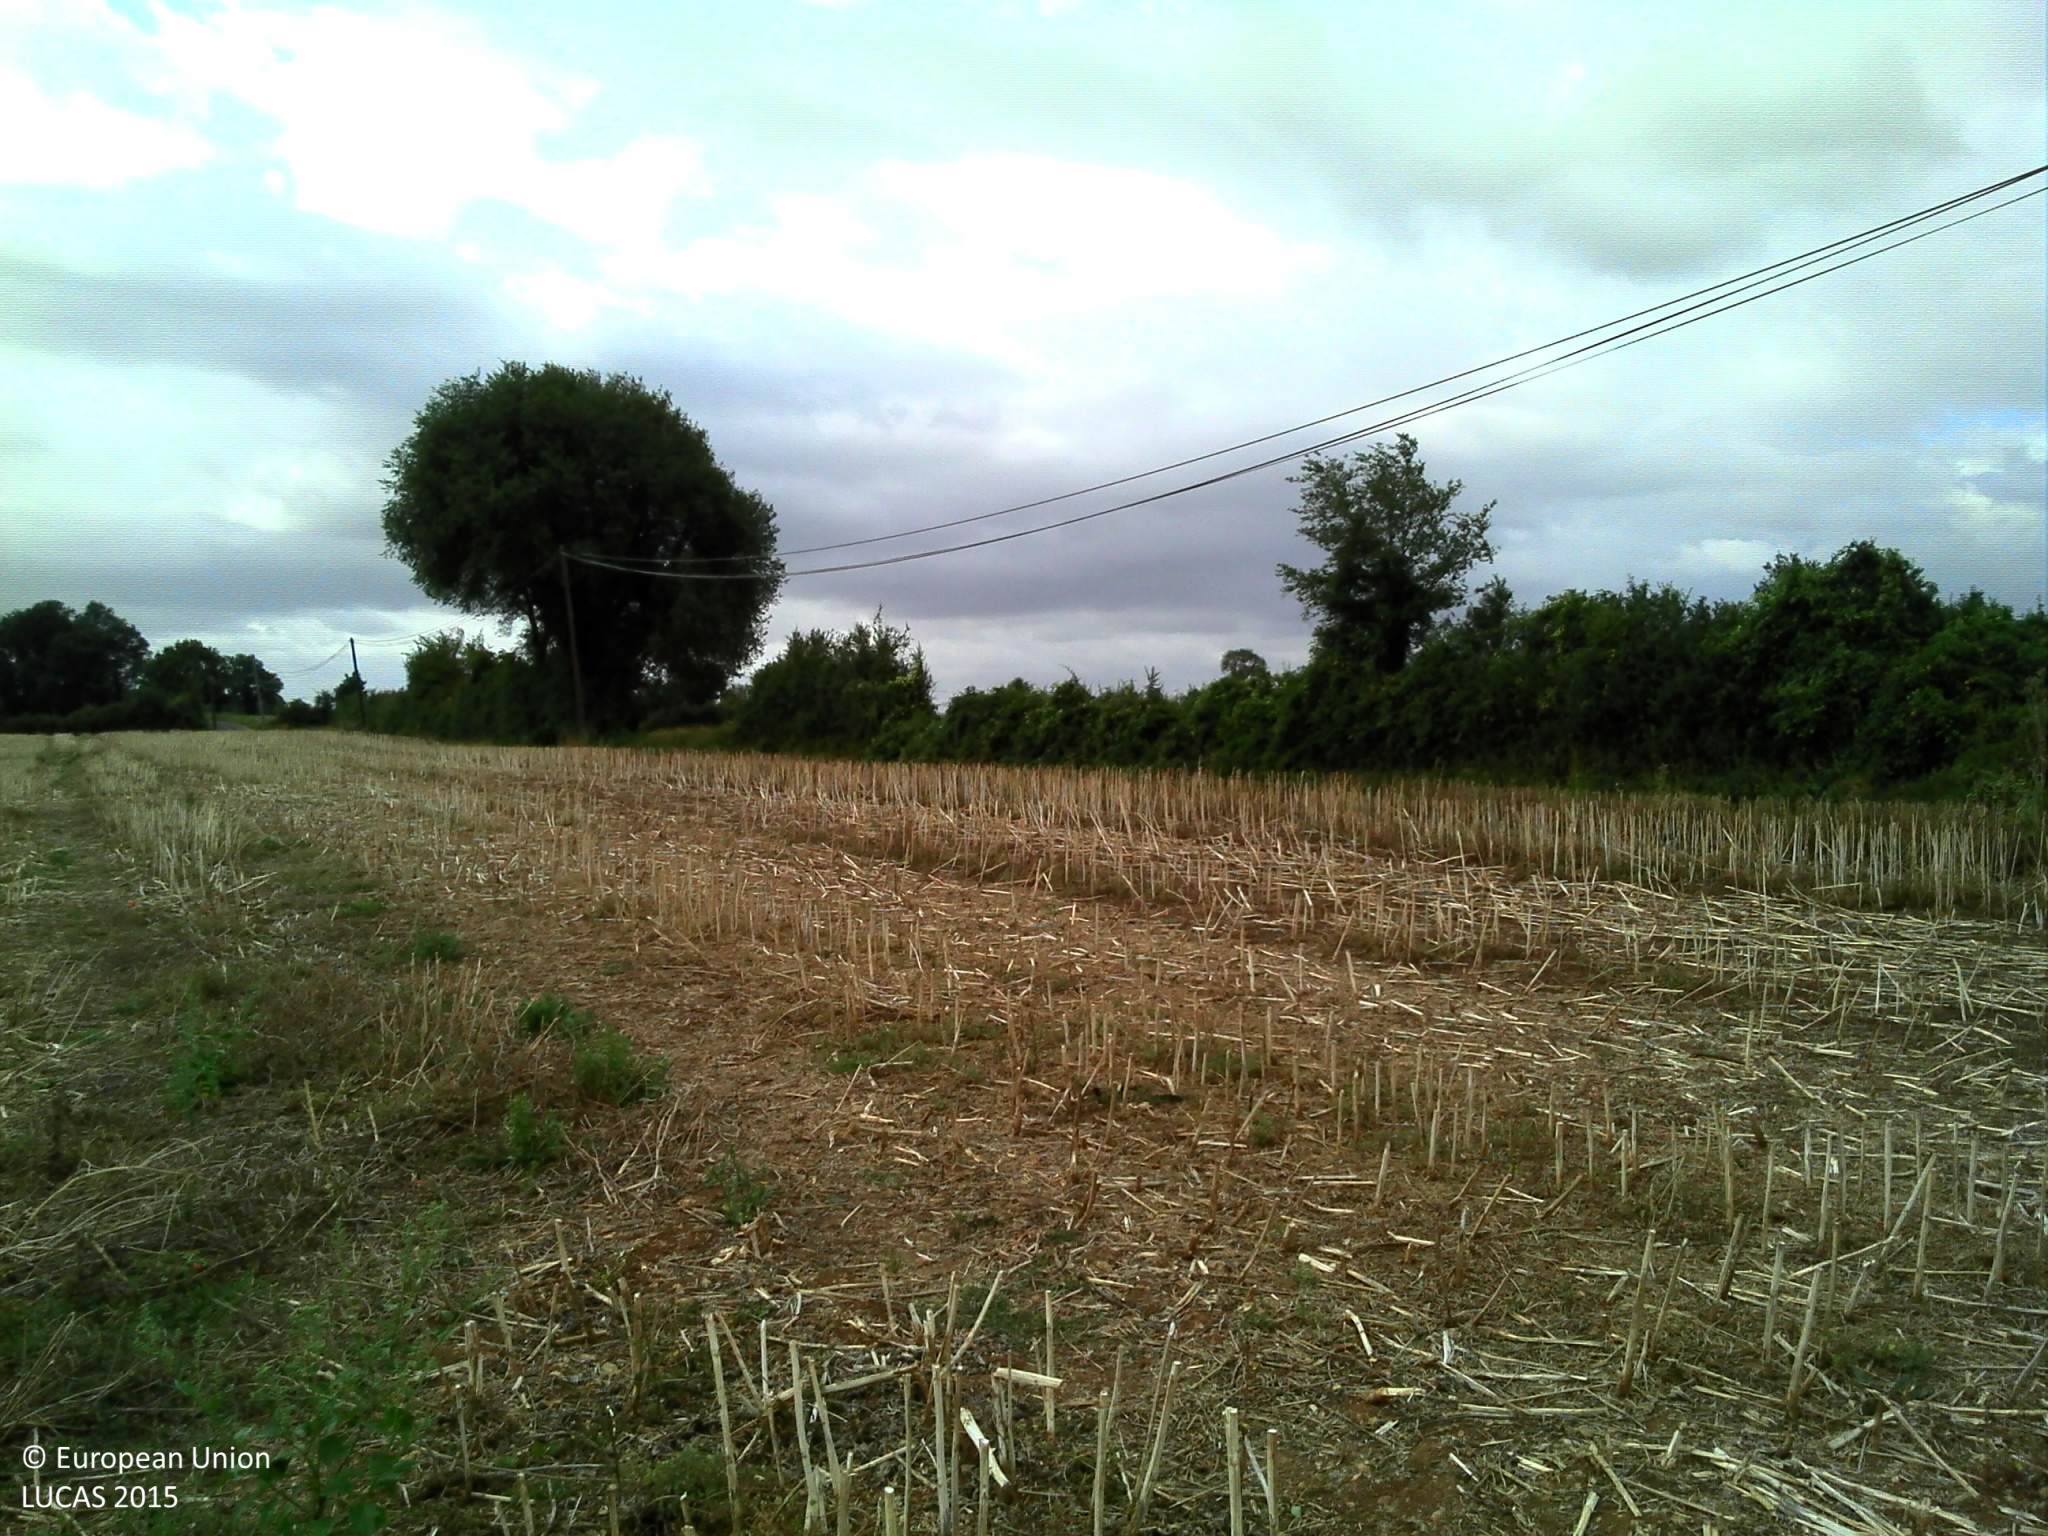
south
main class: Cropland
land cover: Rape and turnip rape
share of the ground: < 10 %
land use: Agriculture (excluding fallow land and kitchen gardens)
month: July
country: FR
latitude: 46.3269
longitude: 0.3048
